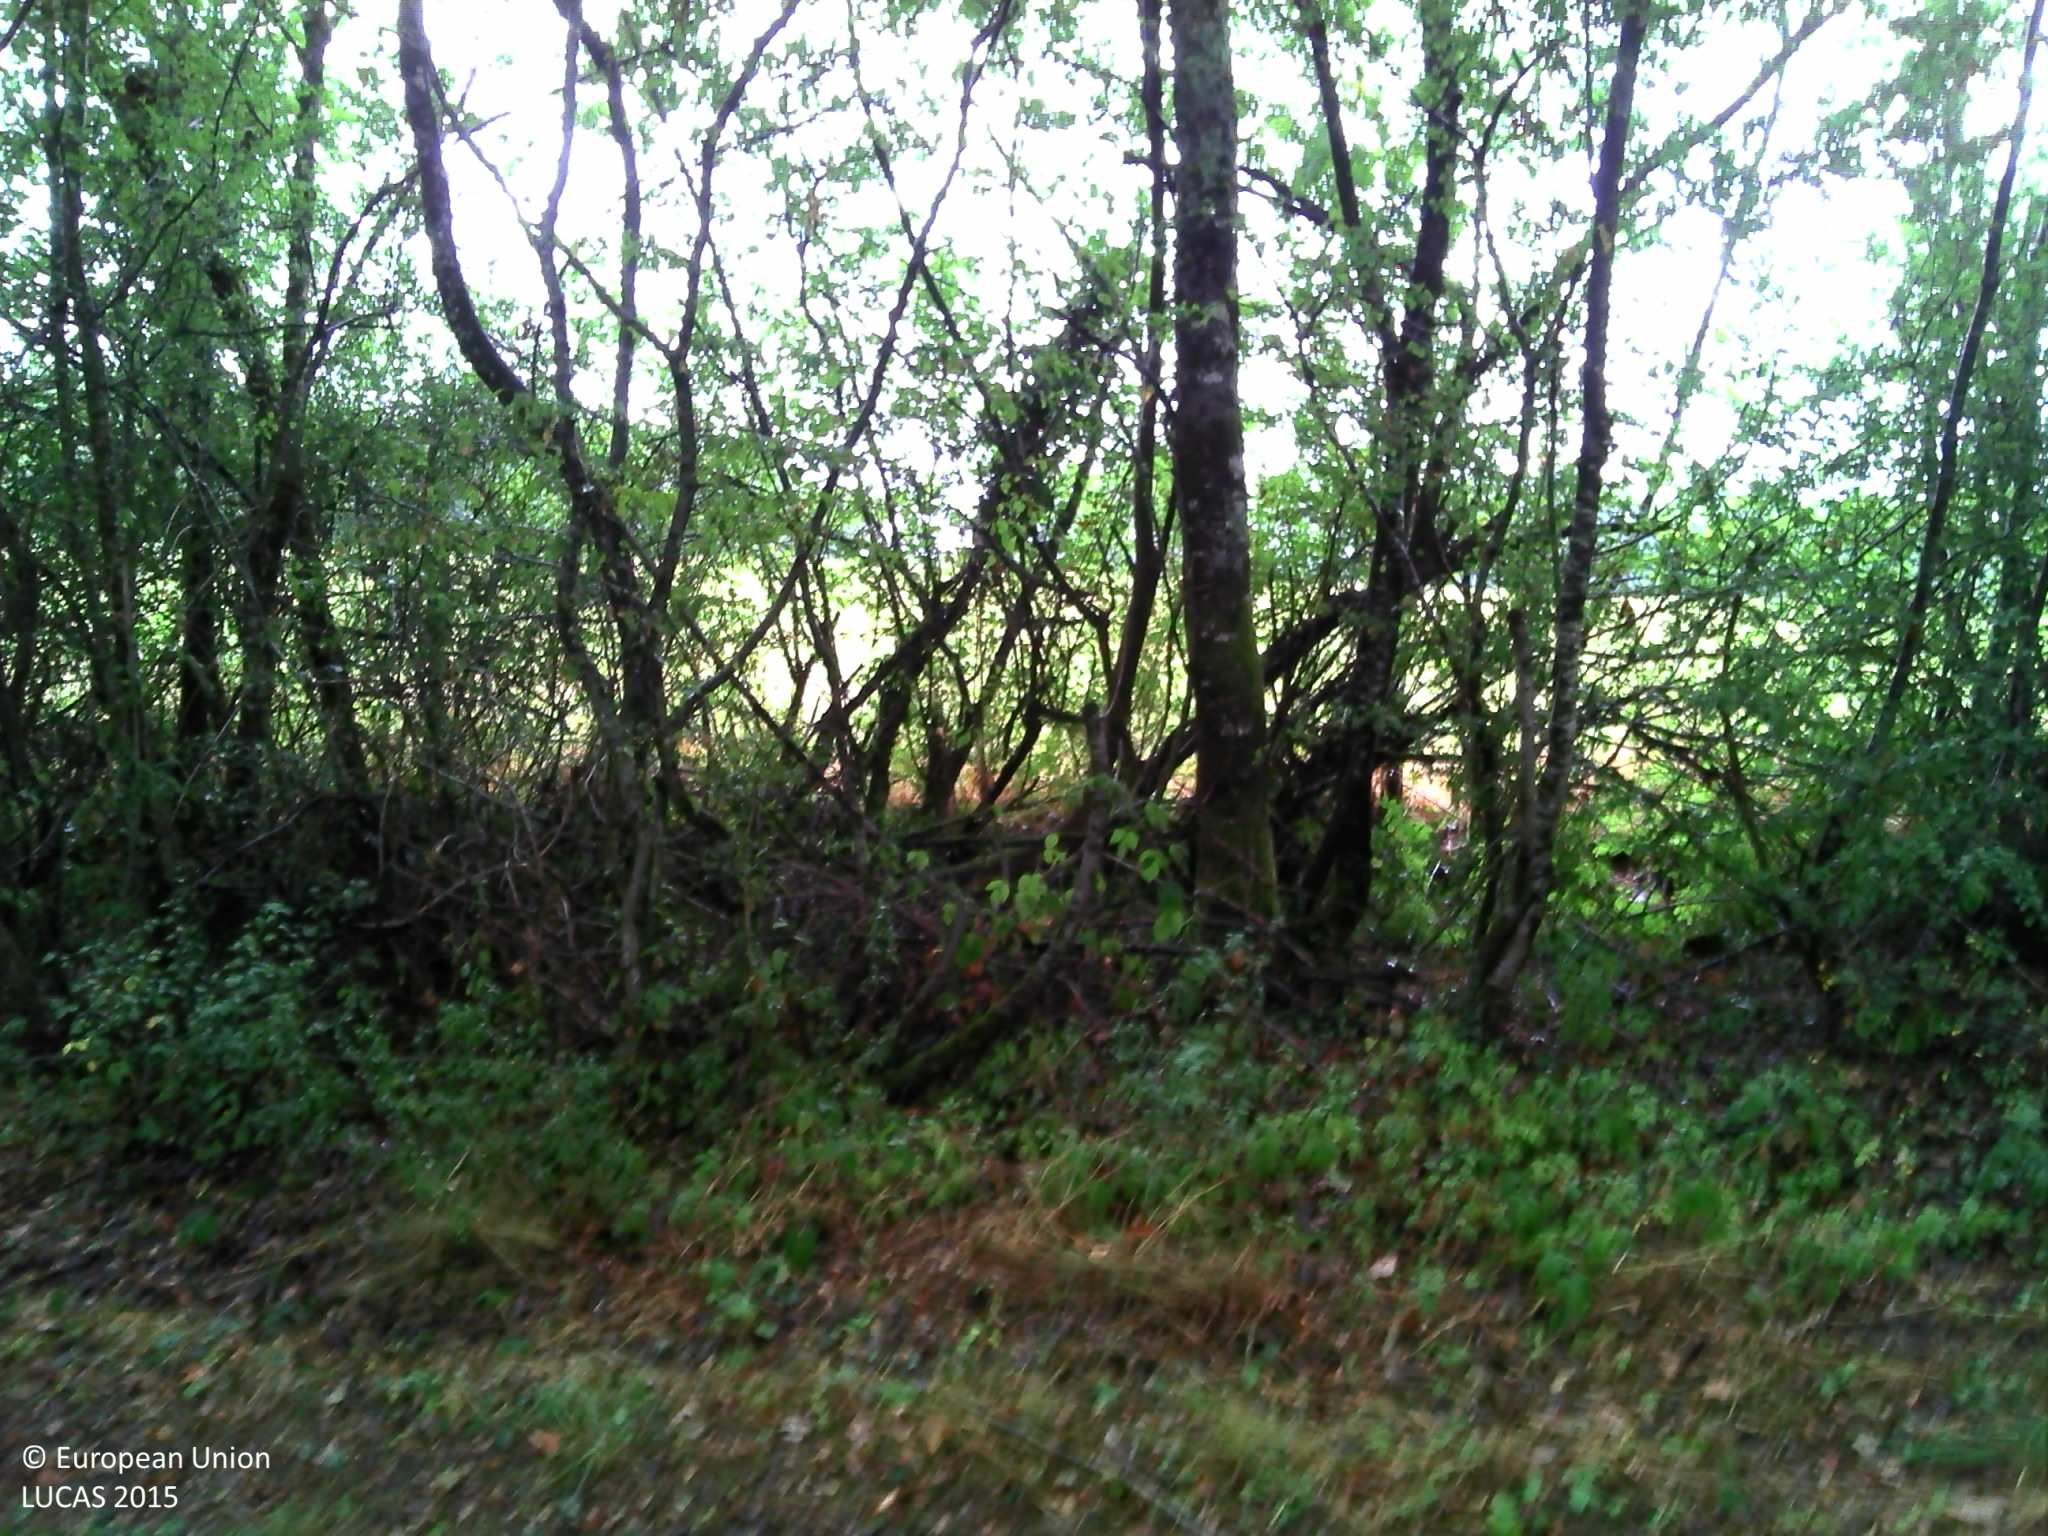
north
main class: Grassland
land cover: Grassland without tree/shrub cover
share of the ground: > 75 %
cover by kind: herbaceous plants 100 %
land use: Agriculture (excluding fallow land and kitchen gardens)
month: August
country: FR
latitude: 47.6127
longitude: 3.1432
